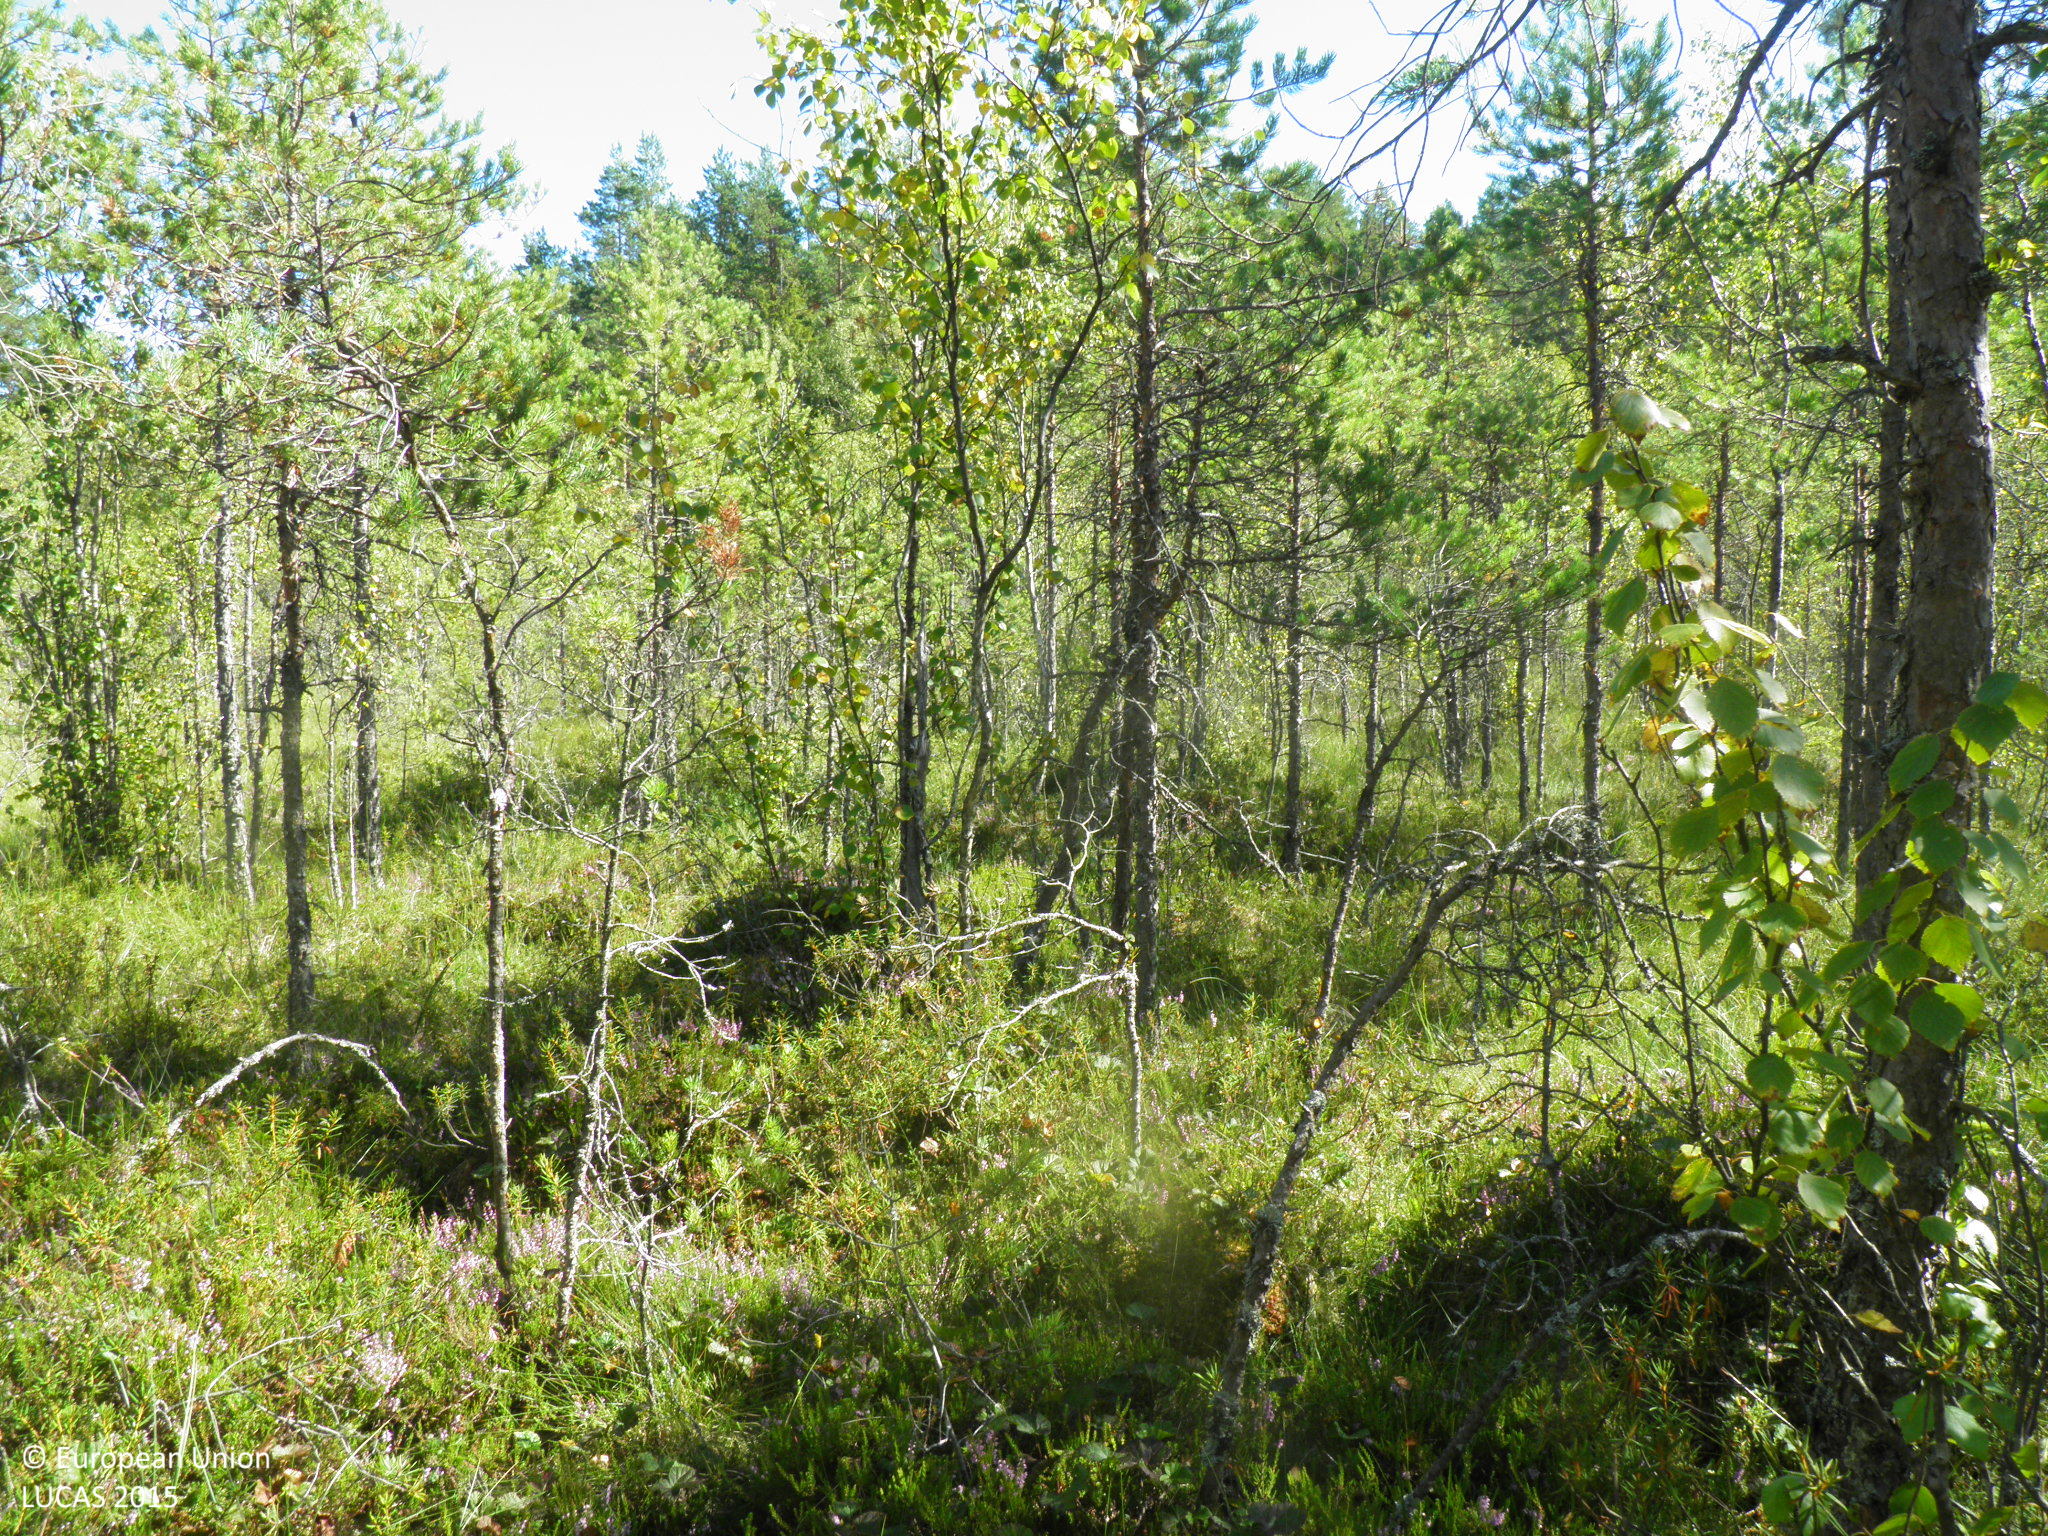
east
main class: Woodland
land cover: Pine dominated mixed woodland
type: mire and swamp forests
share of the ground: 25 - 50 %
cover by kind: coniferous forest trees 30 %, shrubs 30 %, lichens and mosses 20 %, broadleaved forest trees 10 %, herbaceous plants 10 %
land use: Semi-natural and natural areas not in use
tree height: < 5 m
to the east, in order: Pine dominated mixed woodland; Pine dominated coniferous woodland; Spruce dominated coniferous woodland; Other coniferous woodland
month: August
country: FI
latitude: 60.8963
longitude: 21.4625
